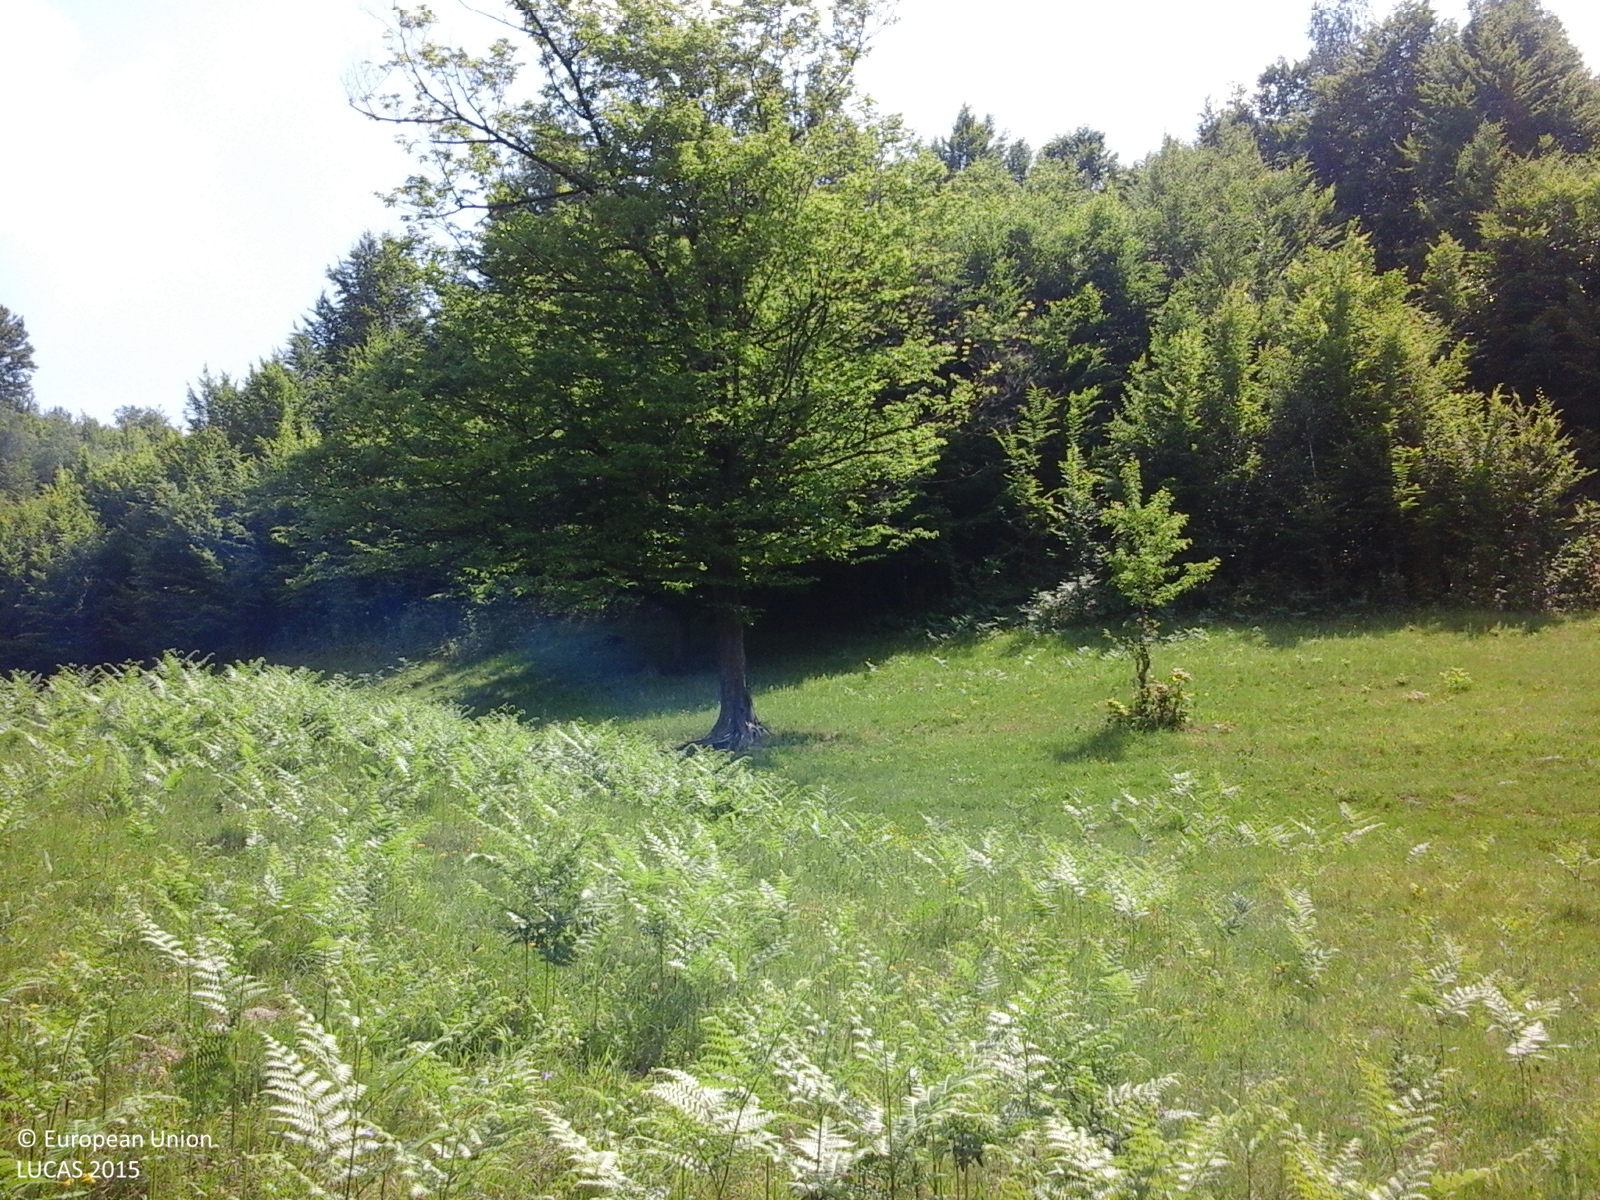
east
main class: Grassland
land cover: Grassland with sparse tree/shrub cover
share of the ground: > 75 %
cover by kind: herbaceous plants 95 %, broadleaved forest trees 5 %
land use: Agriculture (excluding fallow land and kitchen gardens)
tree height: > 5 m
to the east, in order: Grassland with sparse tree/shrub cover; Broadleaved woodland; Grassland without tree/shrub cover
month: June
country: RO
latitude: 46.3360
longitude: 26.4351
